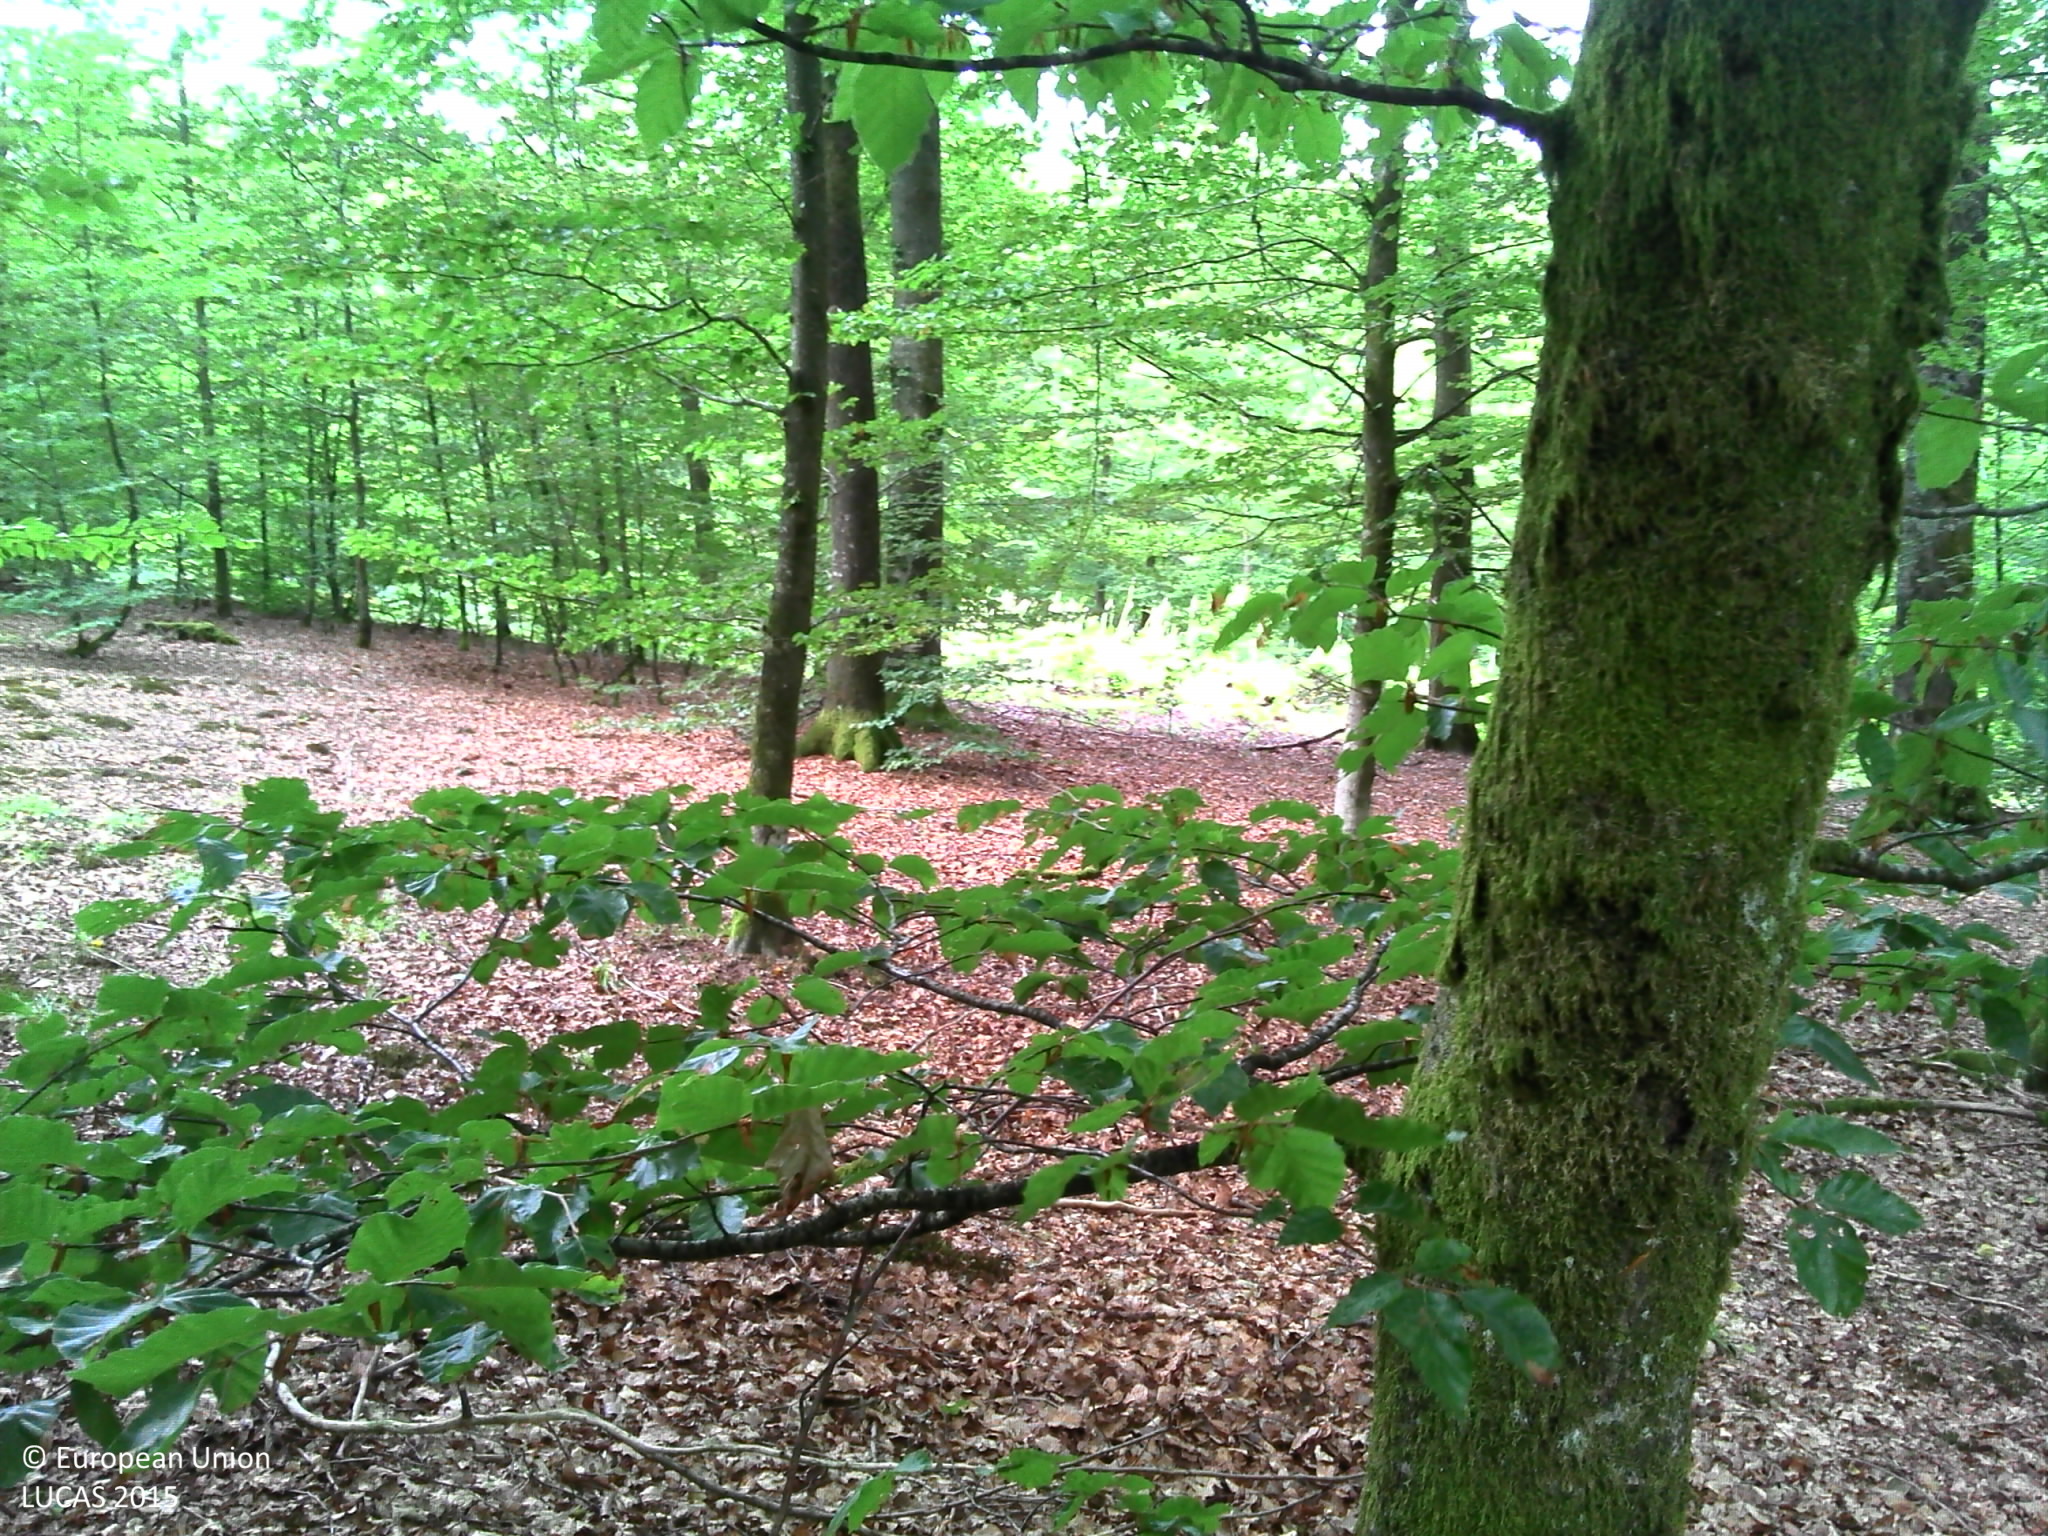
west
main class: Woodland
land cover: Broadleaved woodland
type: beech forest
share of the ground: > 75 %
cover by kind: broadleaved forest trees 90 %, unconsolidated bare surface 10 %
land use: Forestry
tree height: > 5 m
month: July
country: BE
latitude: 49.7783
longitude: 5.6798
